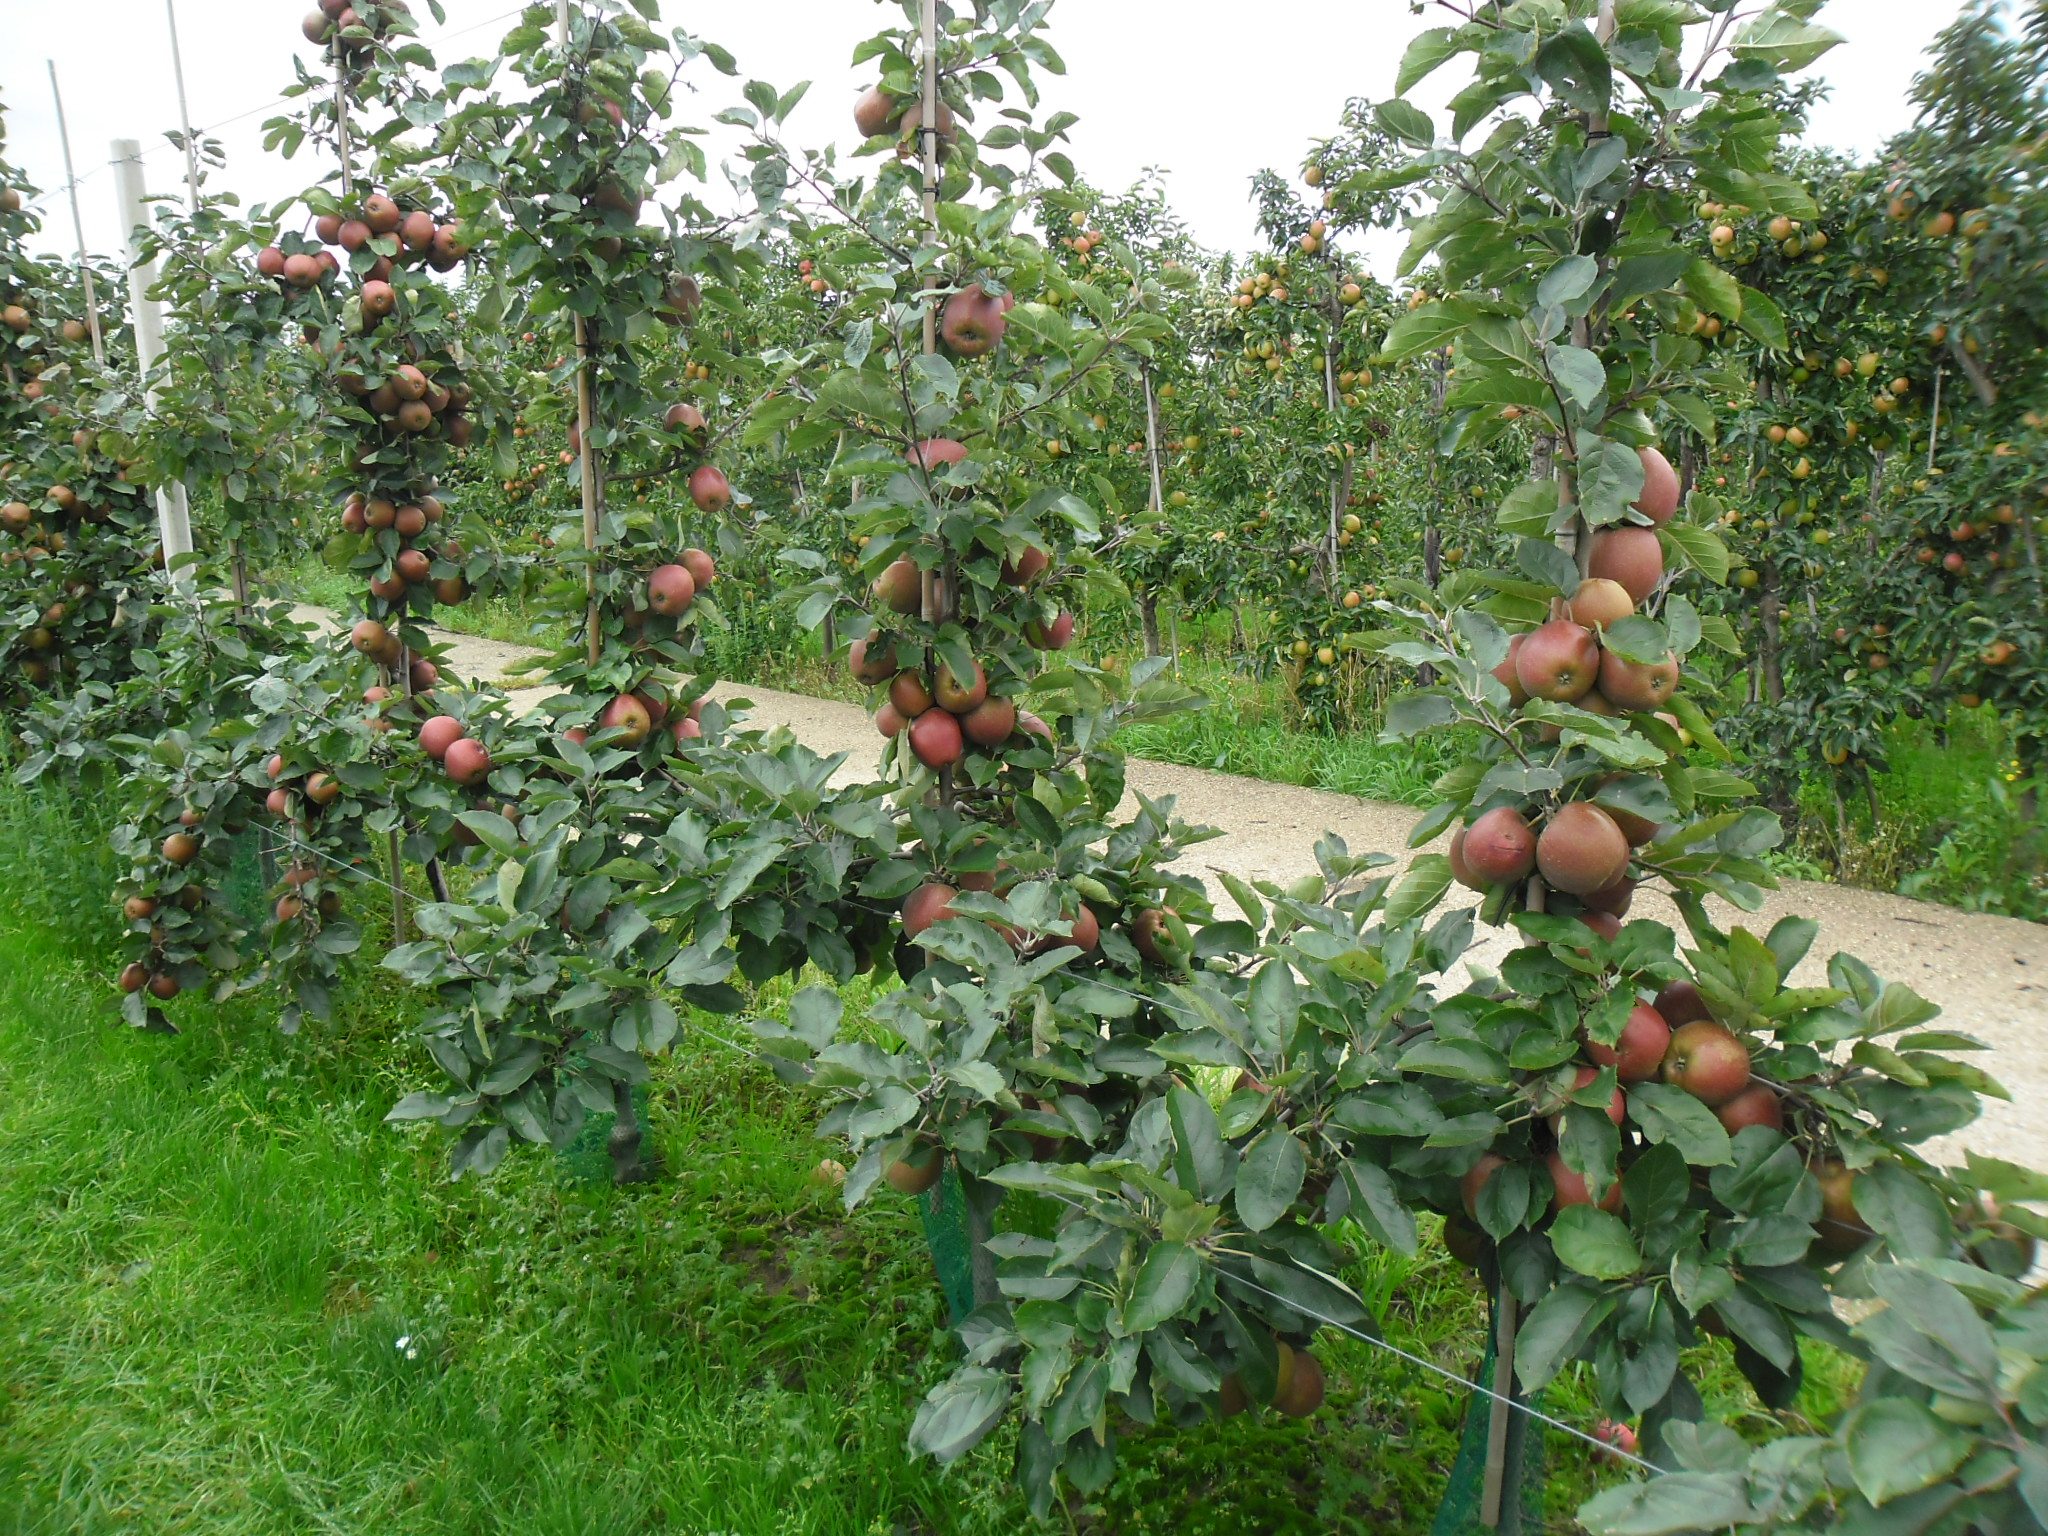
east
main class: Cropland
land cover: Apple fruit
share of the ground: 50 - 75 %
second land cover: Grassland without tree/shrub cover
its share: 25 - 50 %
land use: Agriculture (excluding fallow land and kitchen gardens)
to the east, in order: Apple fruit; Grassland without tree/shrub cover; Tracks; Apple fruit; Grassland without tree/shrub cover; Ditches and canals; Grassland without tree/shrub cover; Artificial constructions in urban areas
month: September
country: NL
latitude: 51.9682
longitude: 5.5006
